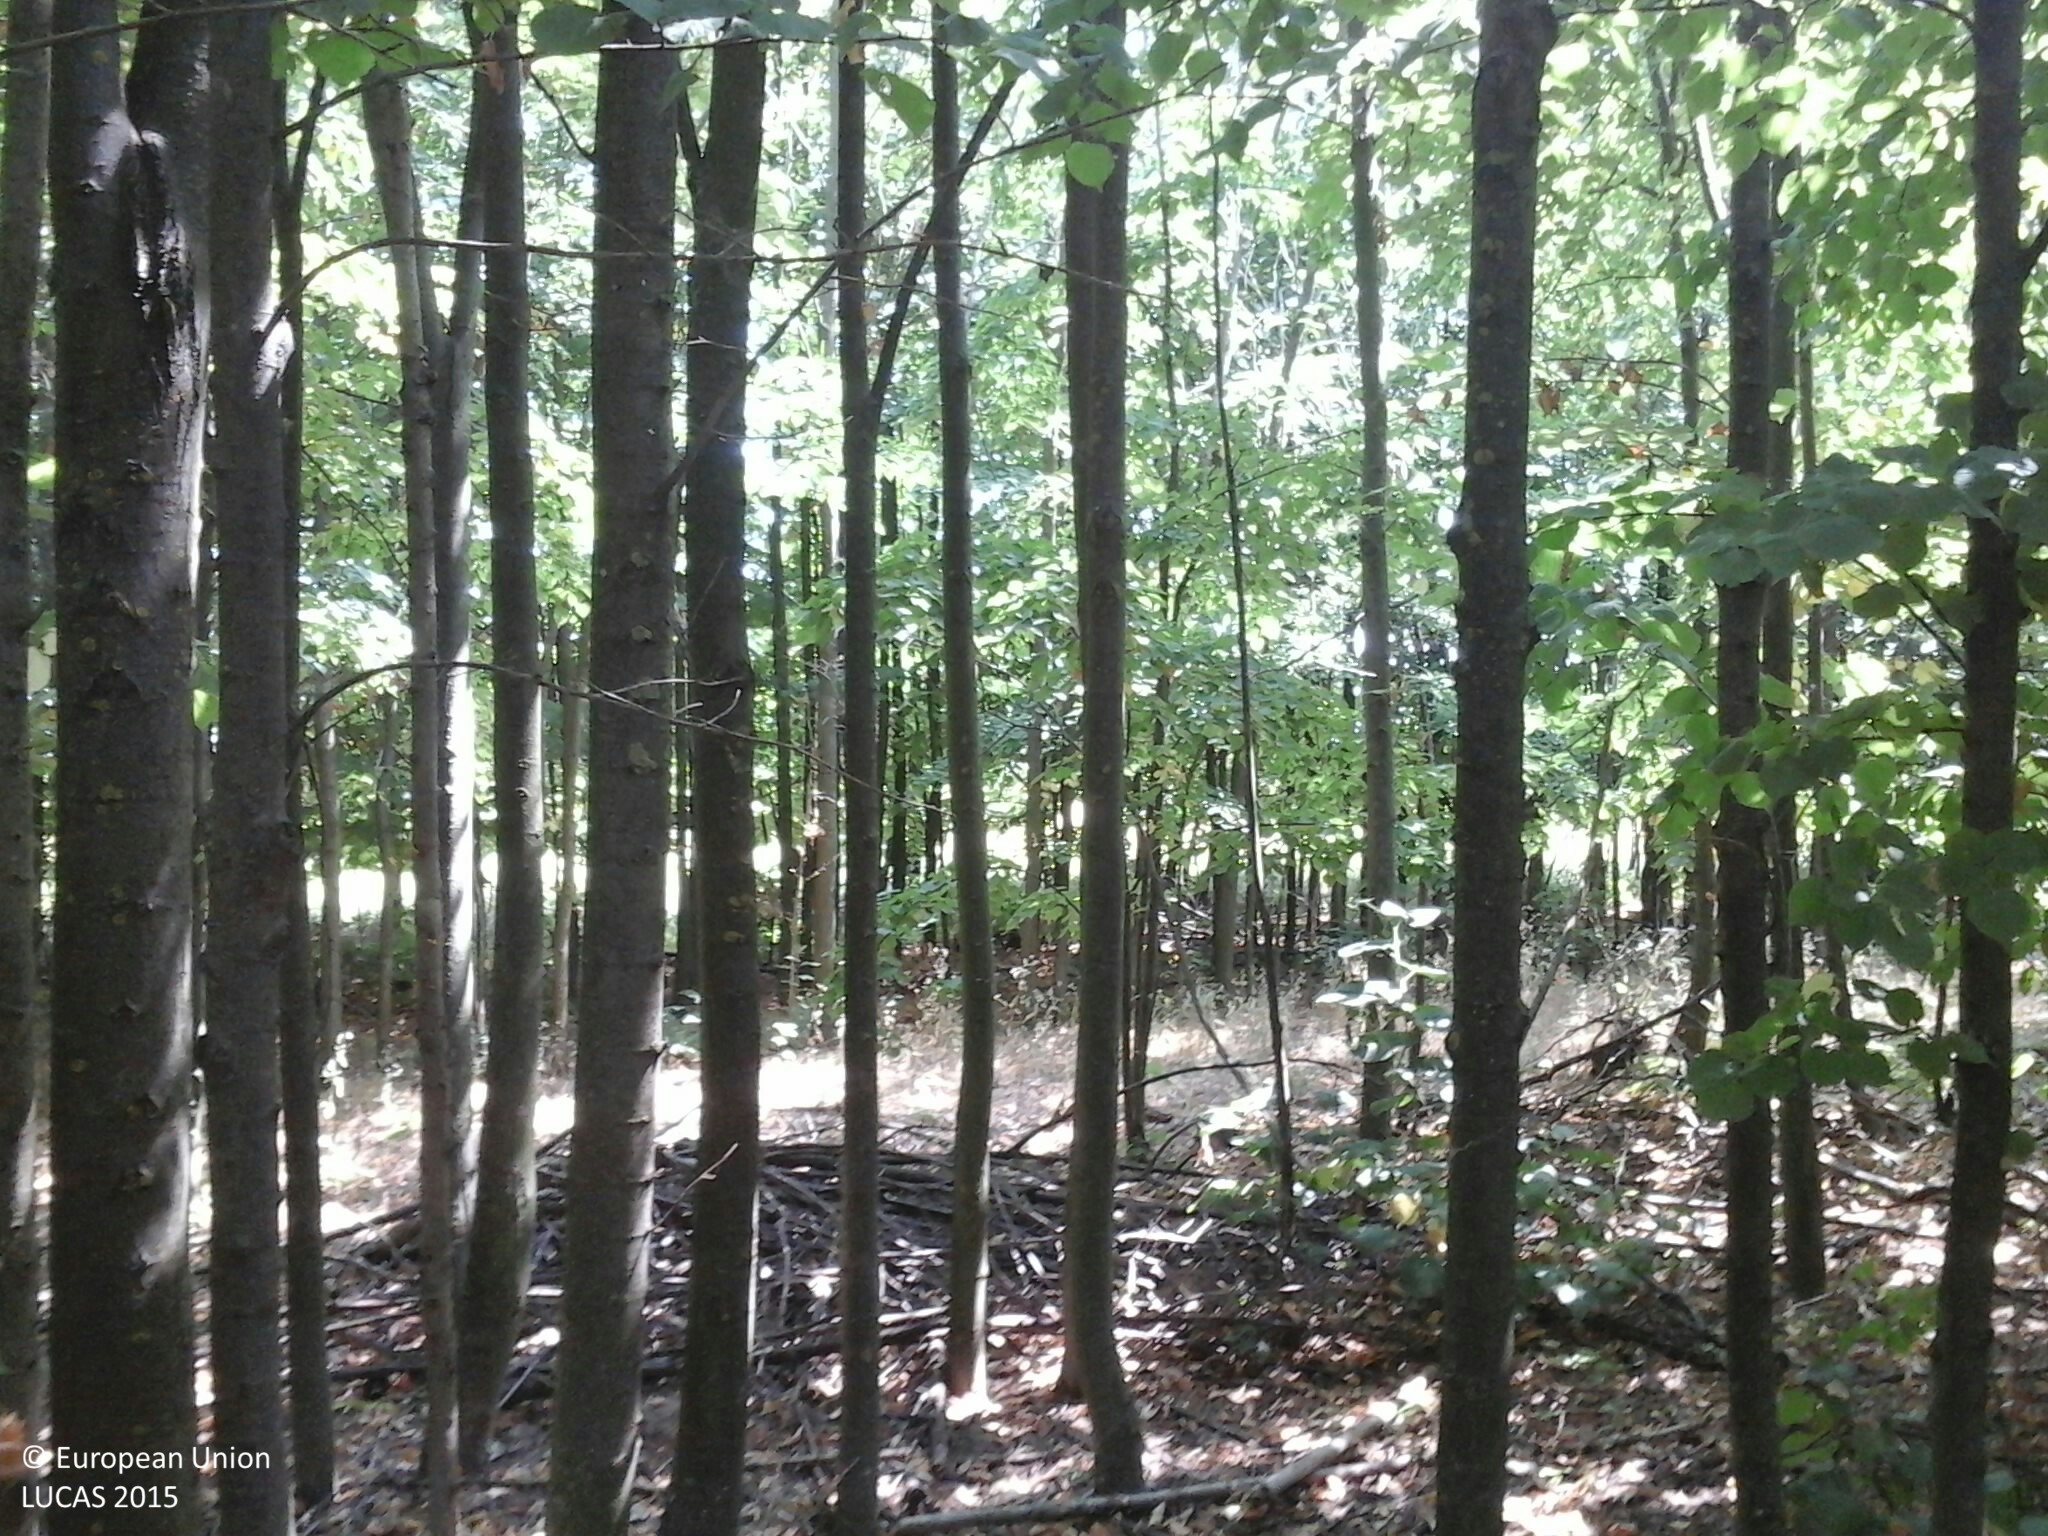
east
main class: Woodland
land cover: Broadleaved woodland
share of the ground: > 75 %
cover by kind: broadleaved forest trees 100 %
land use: Forestry
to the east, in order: Broadleaved woodland; Spontaneously vegetated surfaces; Grass margins; Lines of trees; Grass margins; Maize
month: August
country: HU
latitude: 46.9214
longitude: 18.2176
